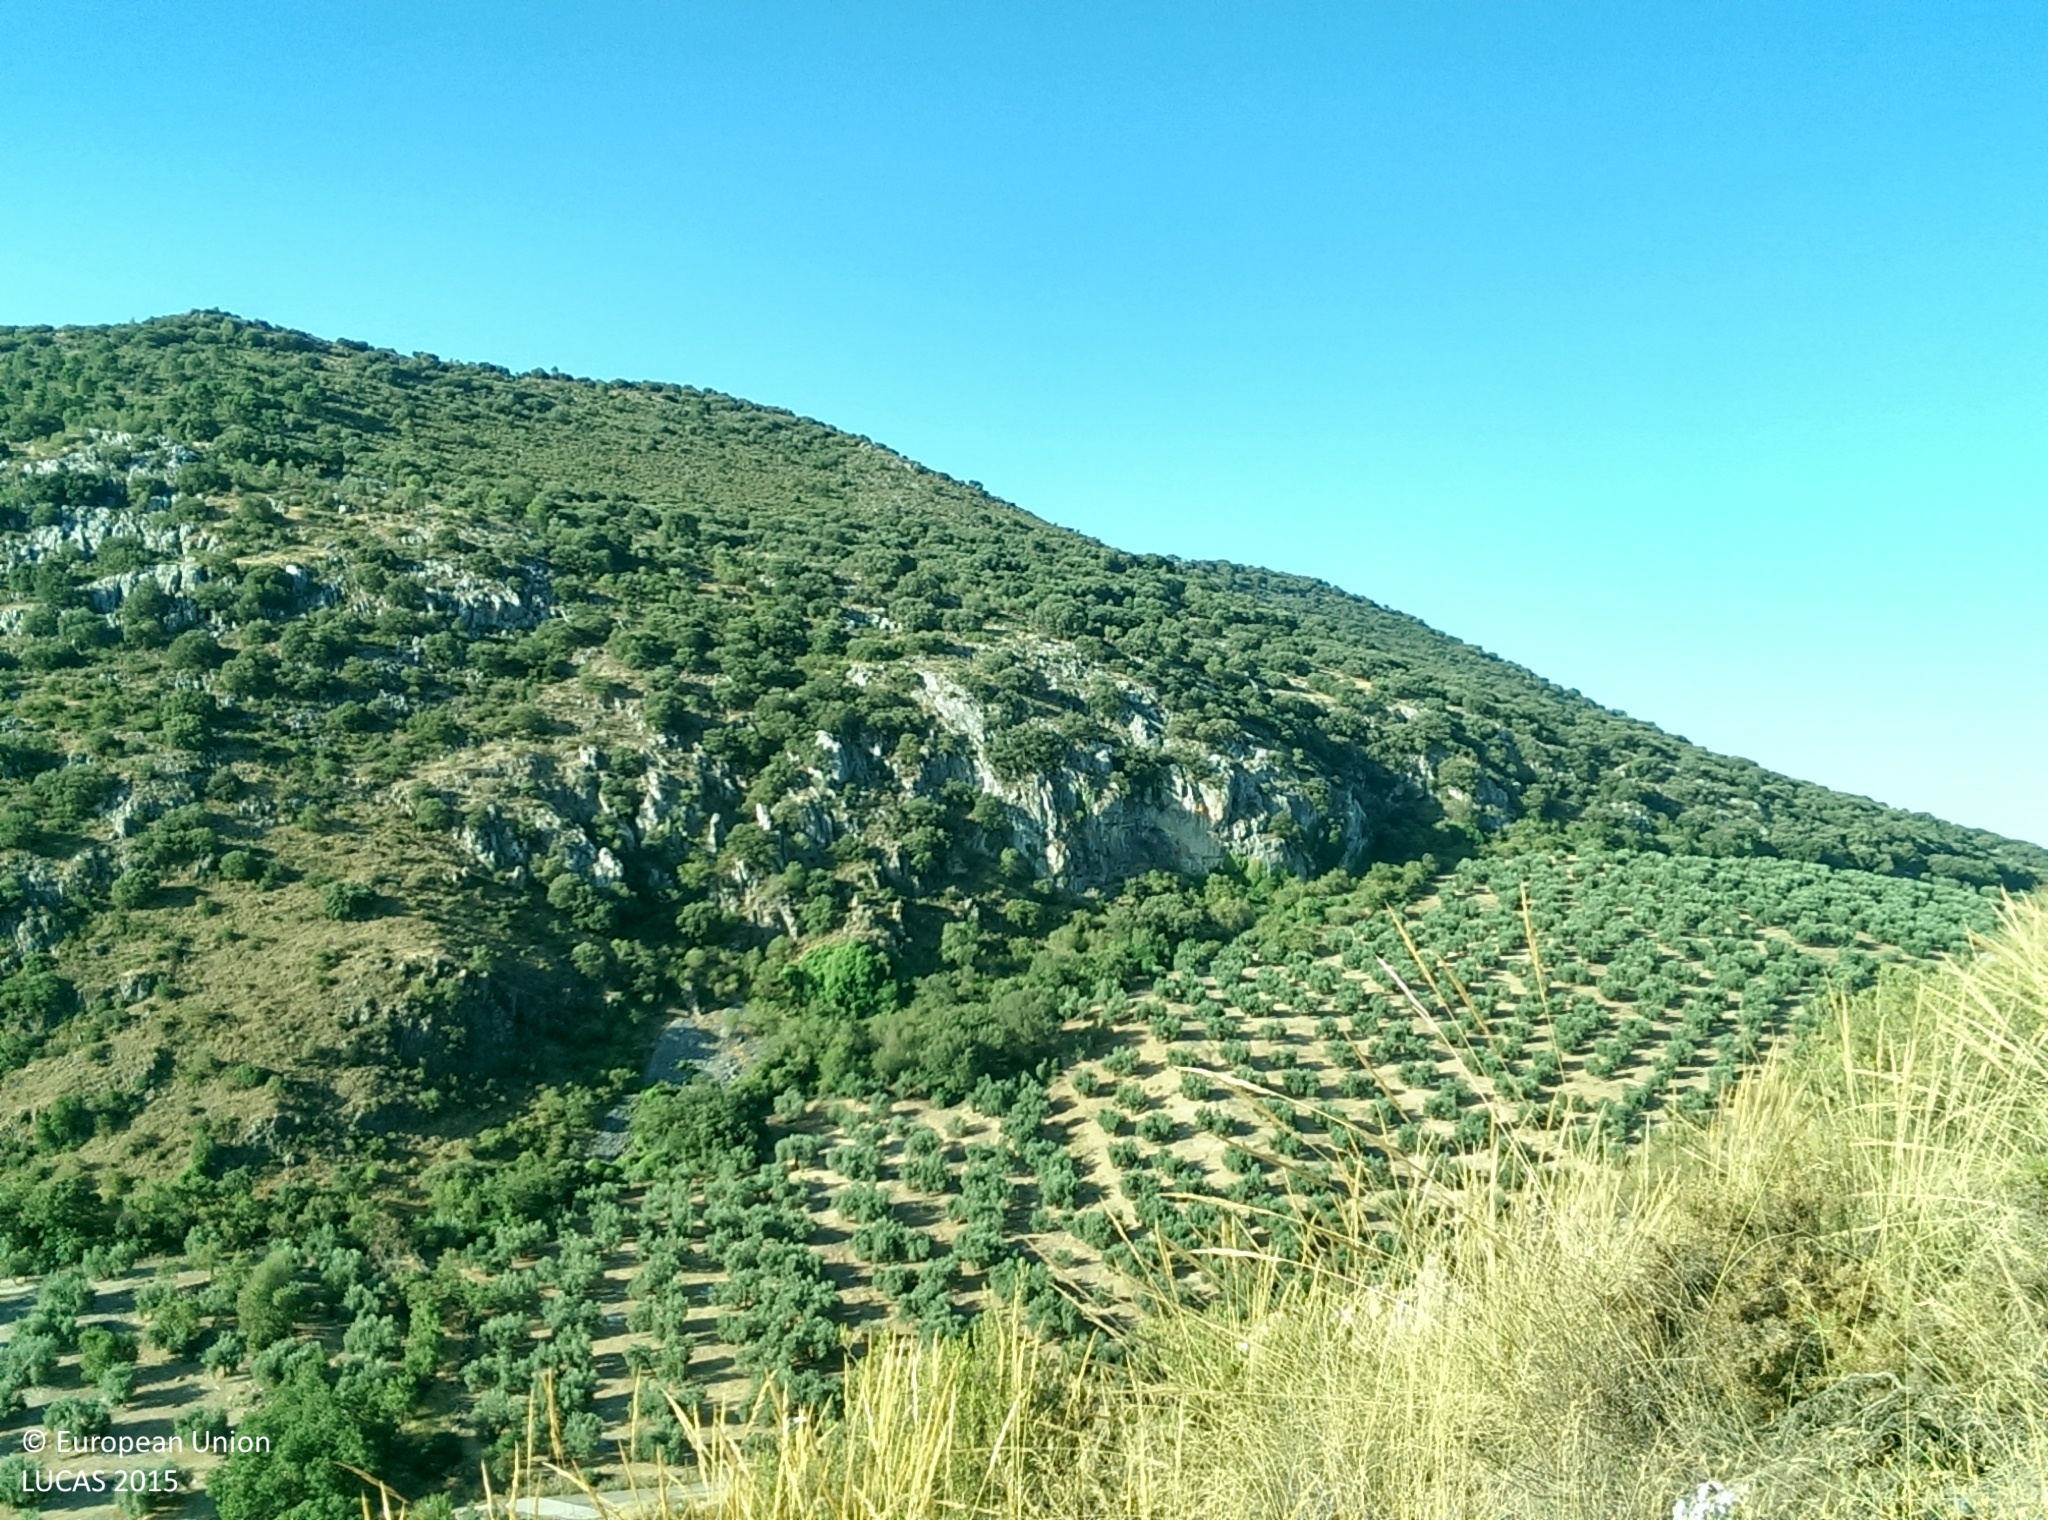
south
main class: Shrubland
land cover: Shrubland without tree cover
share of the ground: 10 - 25 %
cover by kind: herbaceous plants 85 %, shrubs 10 %, consolidated bare surface 5 %
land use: Semi-natural and natural areas not in use
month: July
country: ES
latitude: 37.3879
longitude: -3.7396
